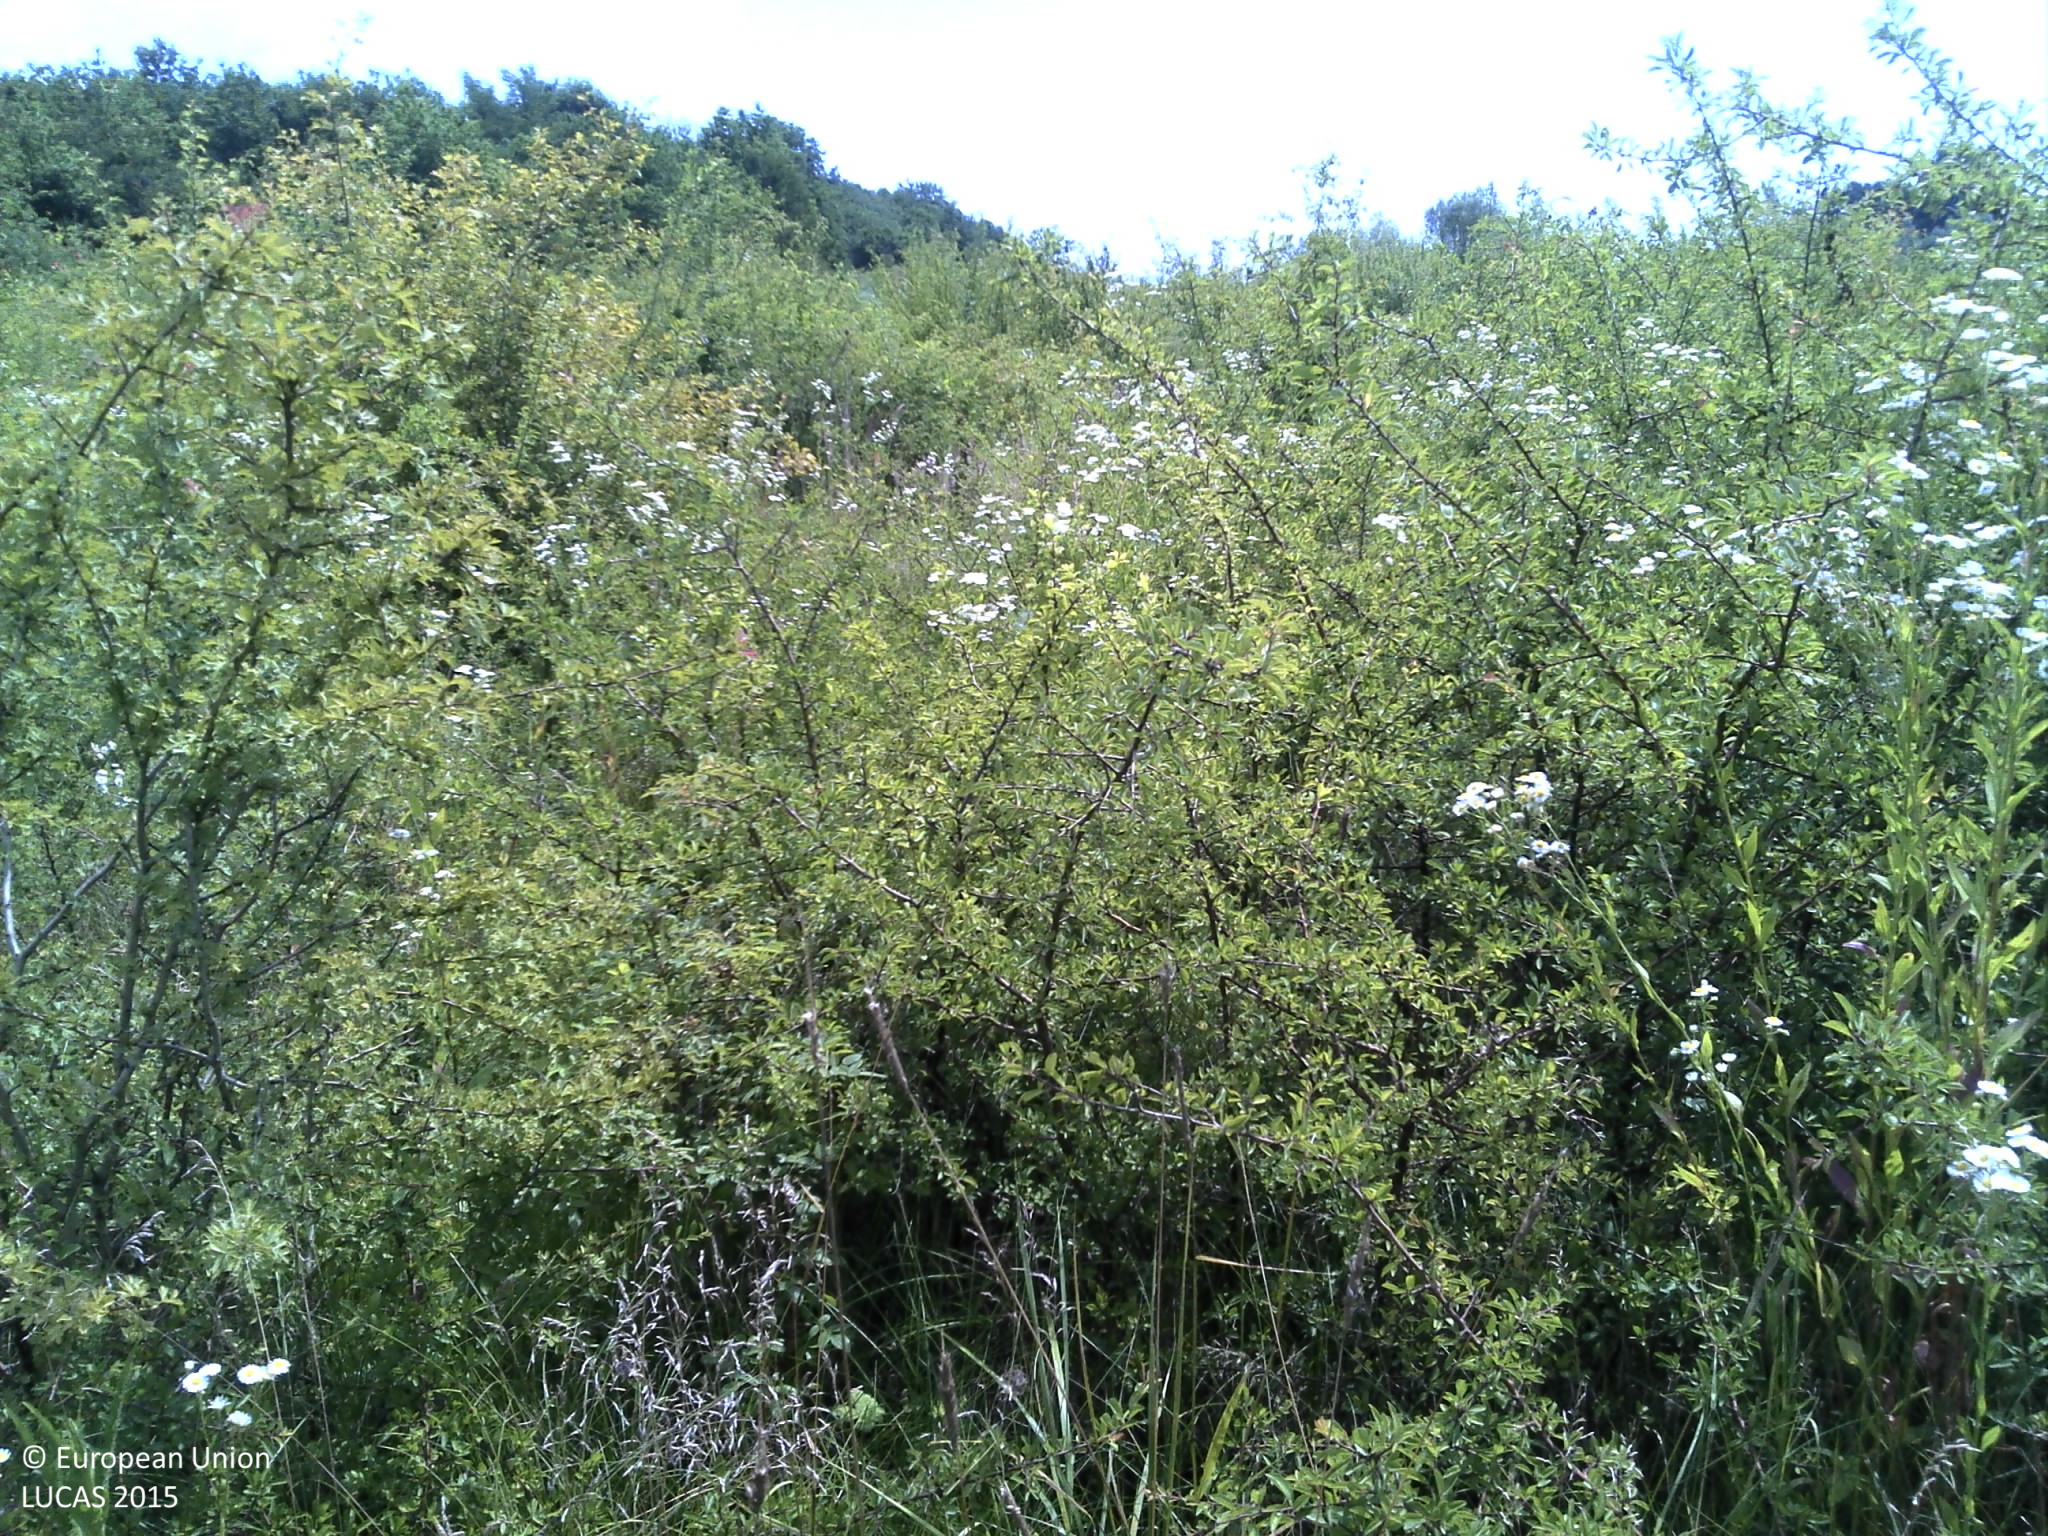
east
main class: Shrubland
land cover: Shrubland with sparse tree cover
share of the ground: > 75 %
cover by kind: shrubs 90 %, broadleaved forest trees 5 %, herbaceous plants 5 %
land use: Fallow land
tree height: < 5 m
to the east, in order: Shrubland with sparse tree cover; Broadleaved woodland; Tracks; Broadleaved woodland
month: June
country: HR
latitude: 45.1547
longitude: 17.3902
